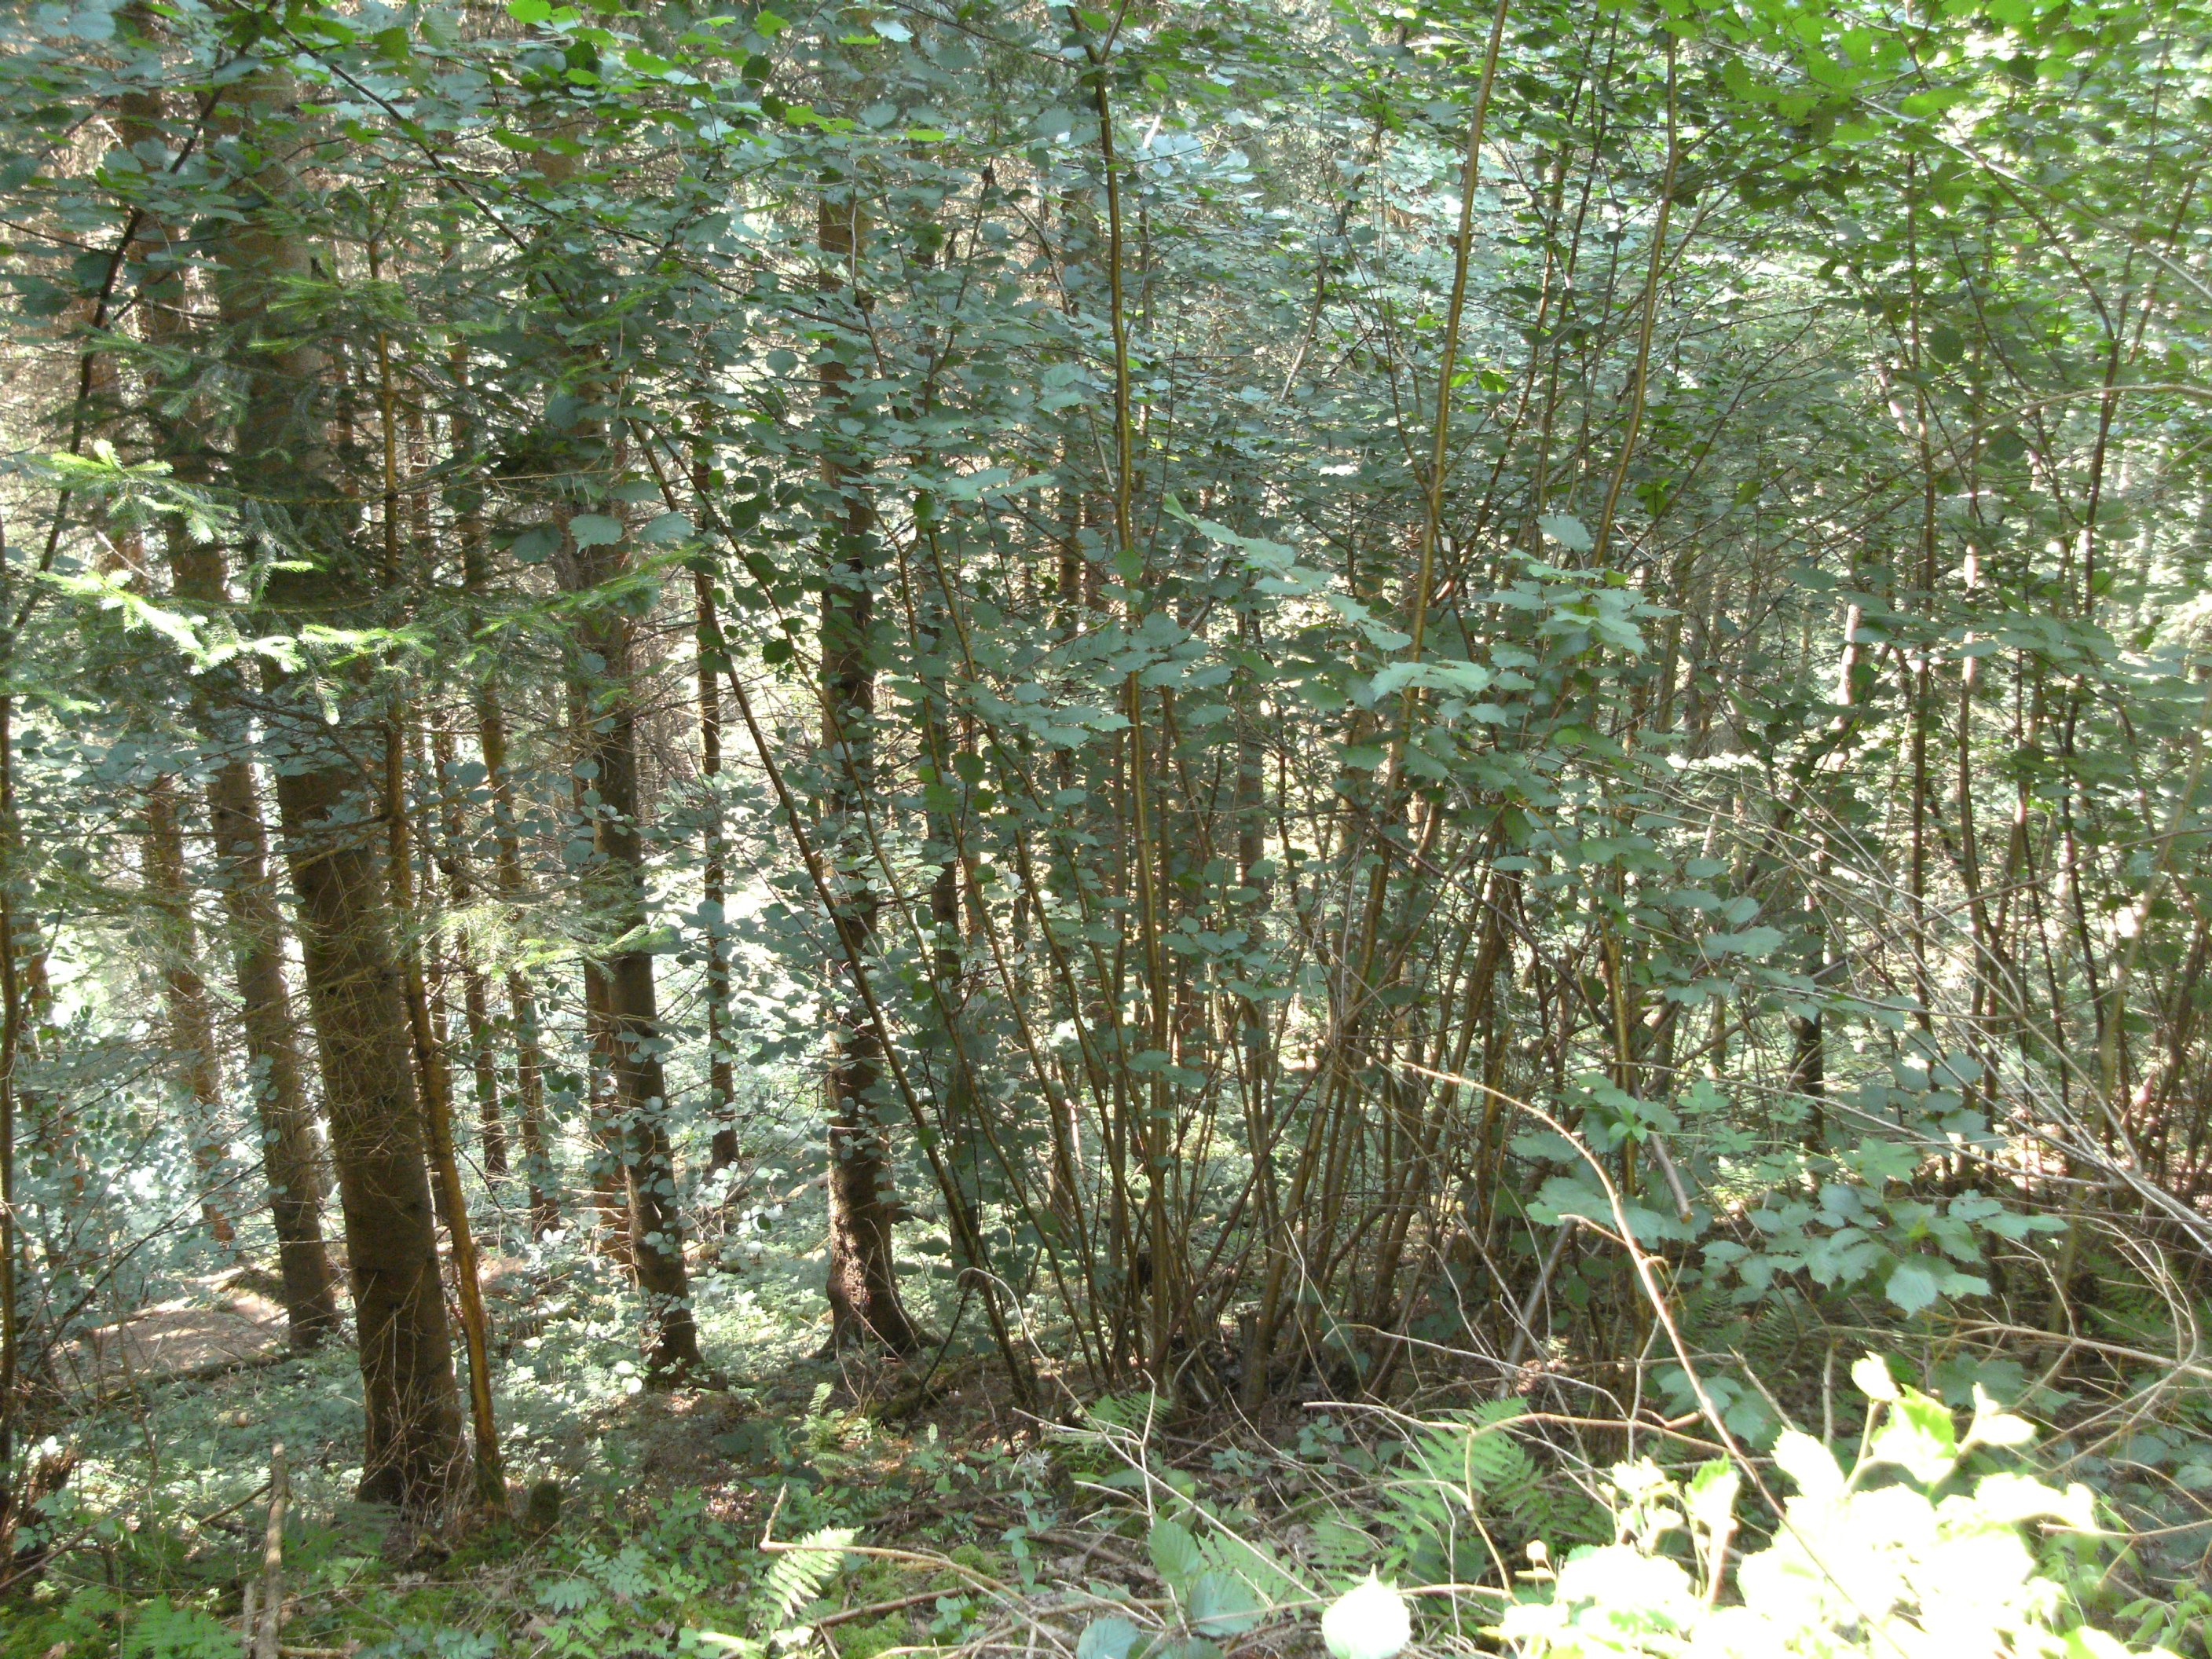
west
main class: Woodland
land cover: Spruce dominated mixed woodland
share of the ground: 50 - 75 %
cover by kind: broadleaved forest trees 35 %, shrubs 30 %, coniferous forest trees 20 %, unconsolidated bare surface 10 %, herbaceous plants 5 %
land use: Forestry
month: July
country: AT
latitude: 46.7677
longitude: 14.7777
